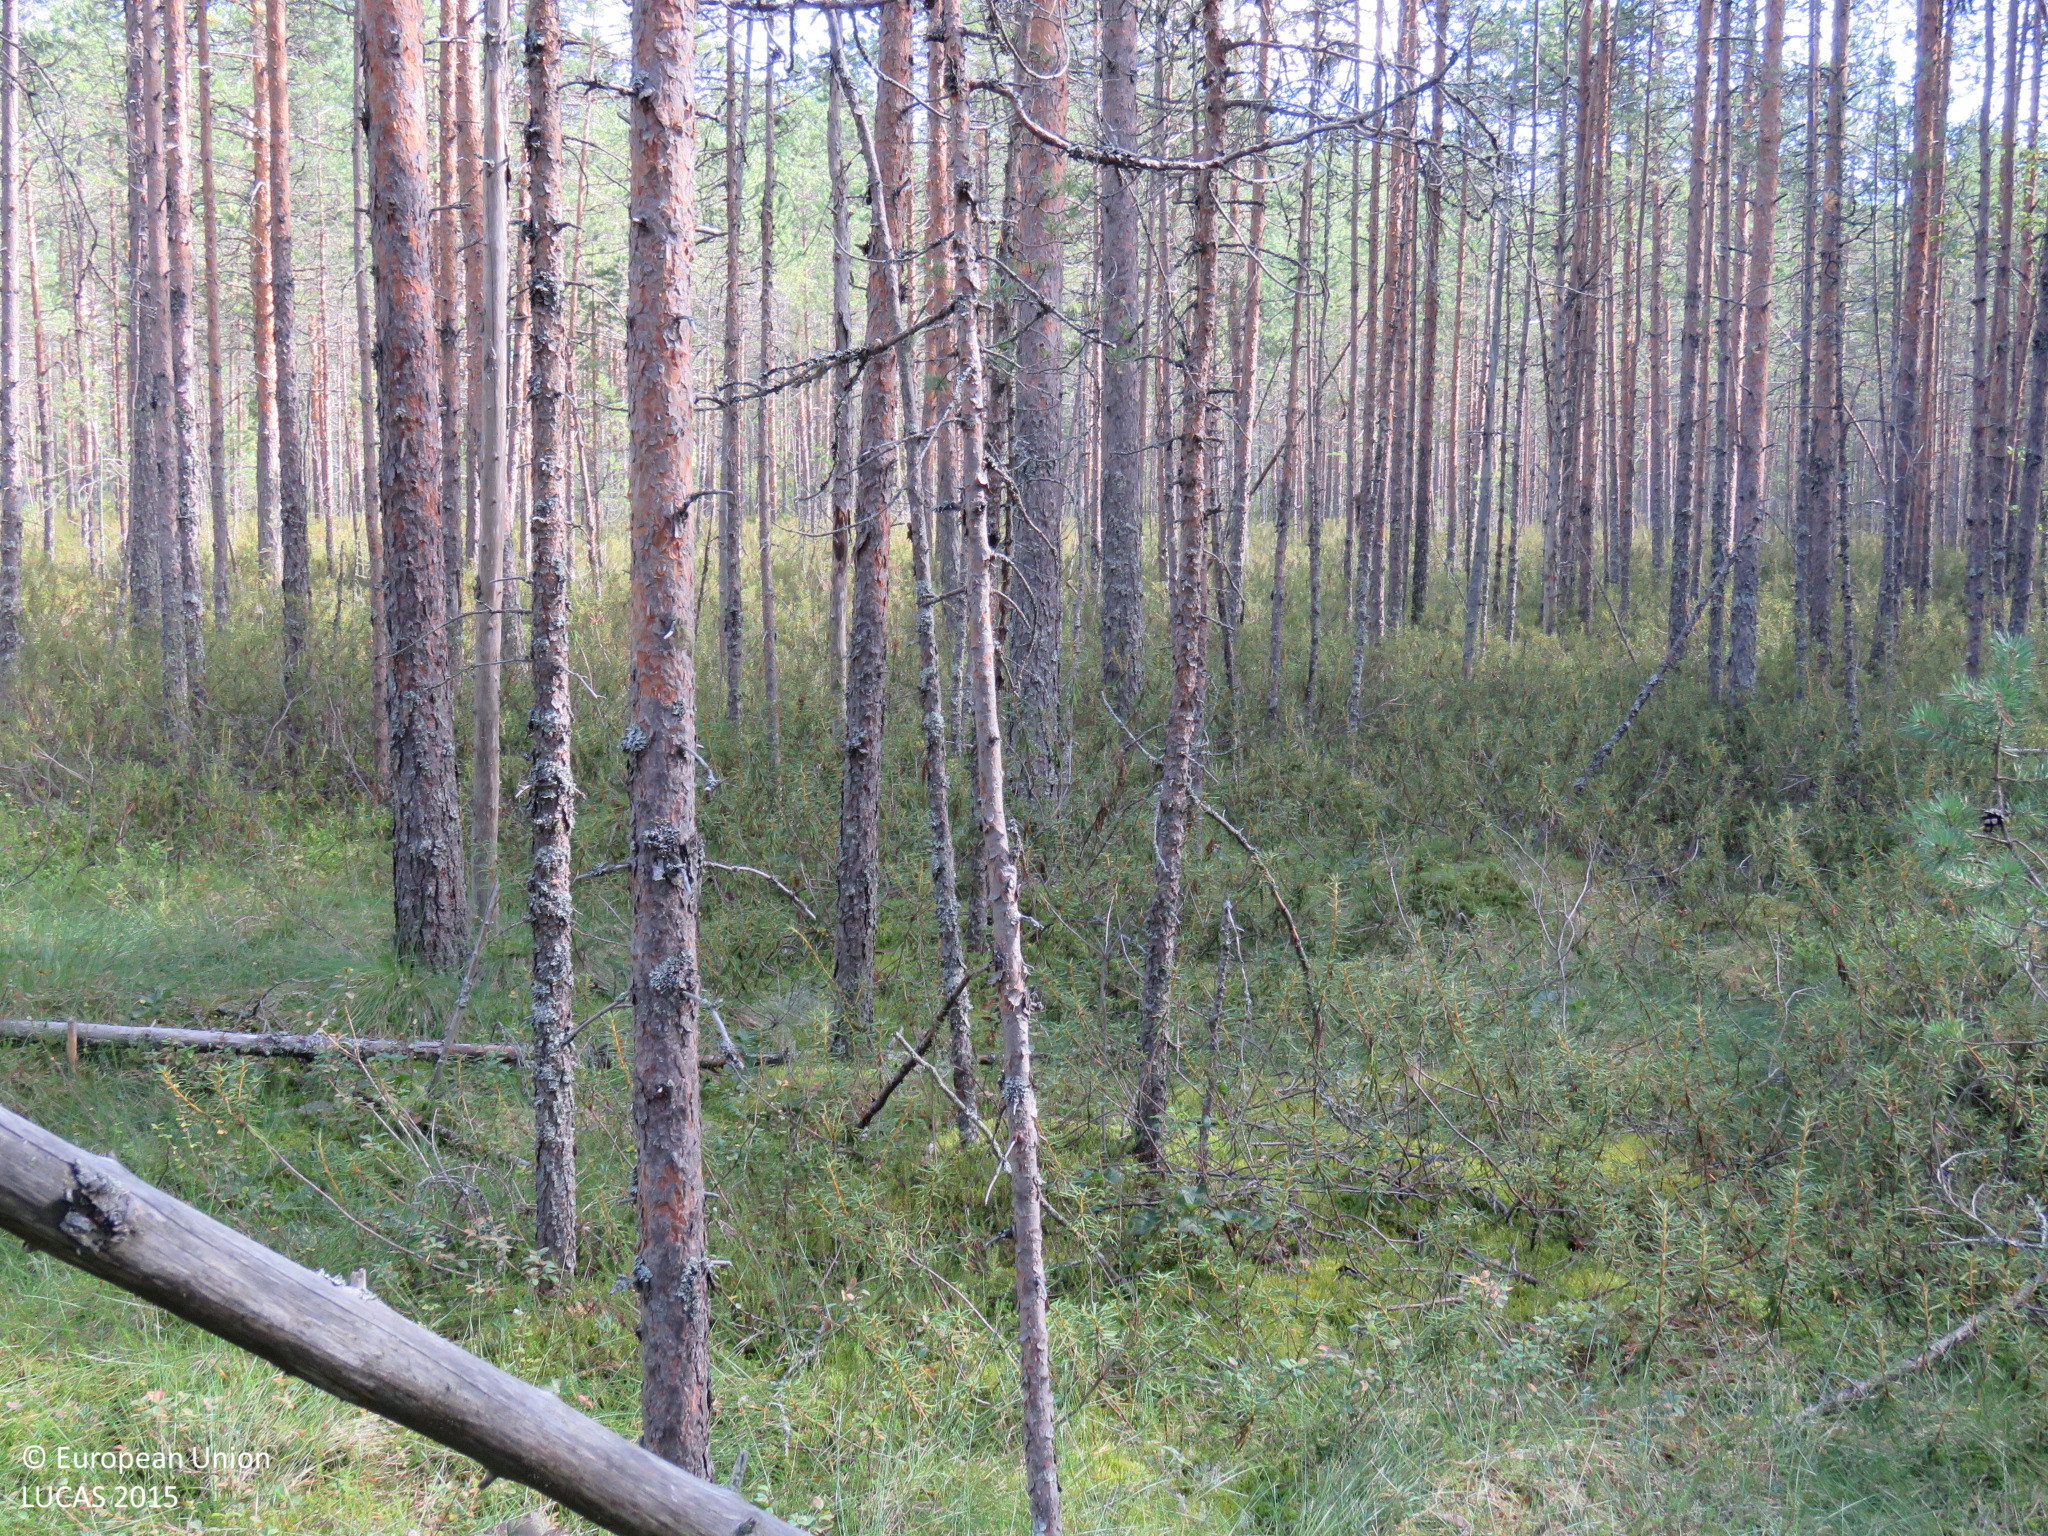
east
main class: Woodland
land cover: Pine dominated coniferous woodland
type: mire and swamp forests
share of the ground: > 75 %
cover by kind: coniferous forest trees 70 %, shrubs 20 %, broadleaved forest trees 5 %, lichens and mosses 5 %
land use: Forestry
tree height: > 5 m
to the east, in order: Pine dominated coniferous woodland; Other coniferous woodland; Pine dominated coniferous woodland; Other coniferous woodland; Tracks; Other coniferous woodland
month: August
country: FI
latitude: 65.1480
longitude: 25.6742
